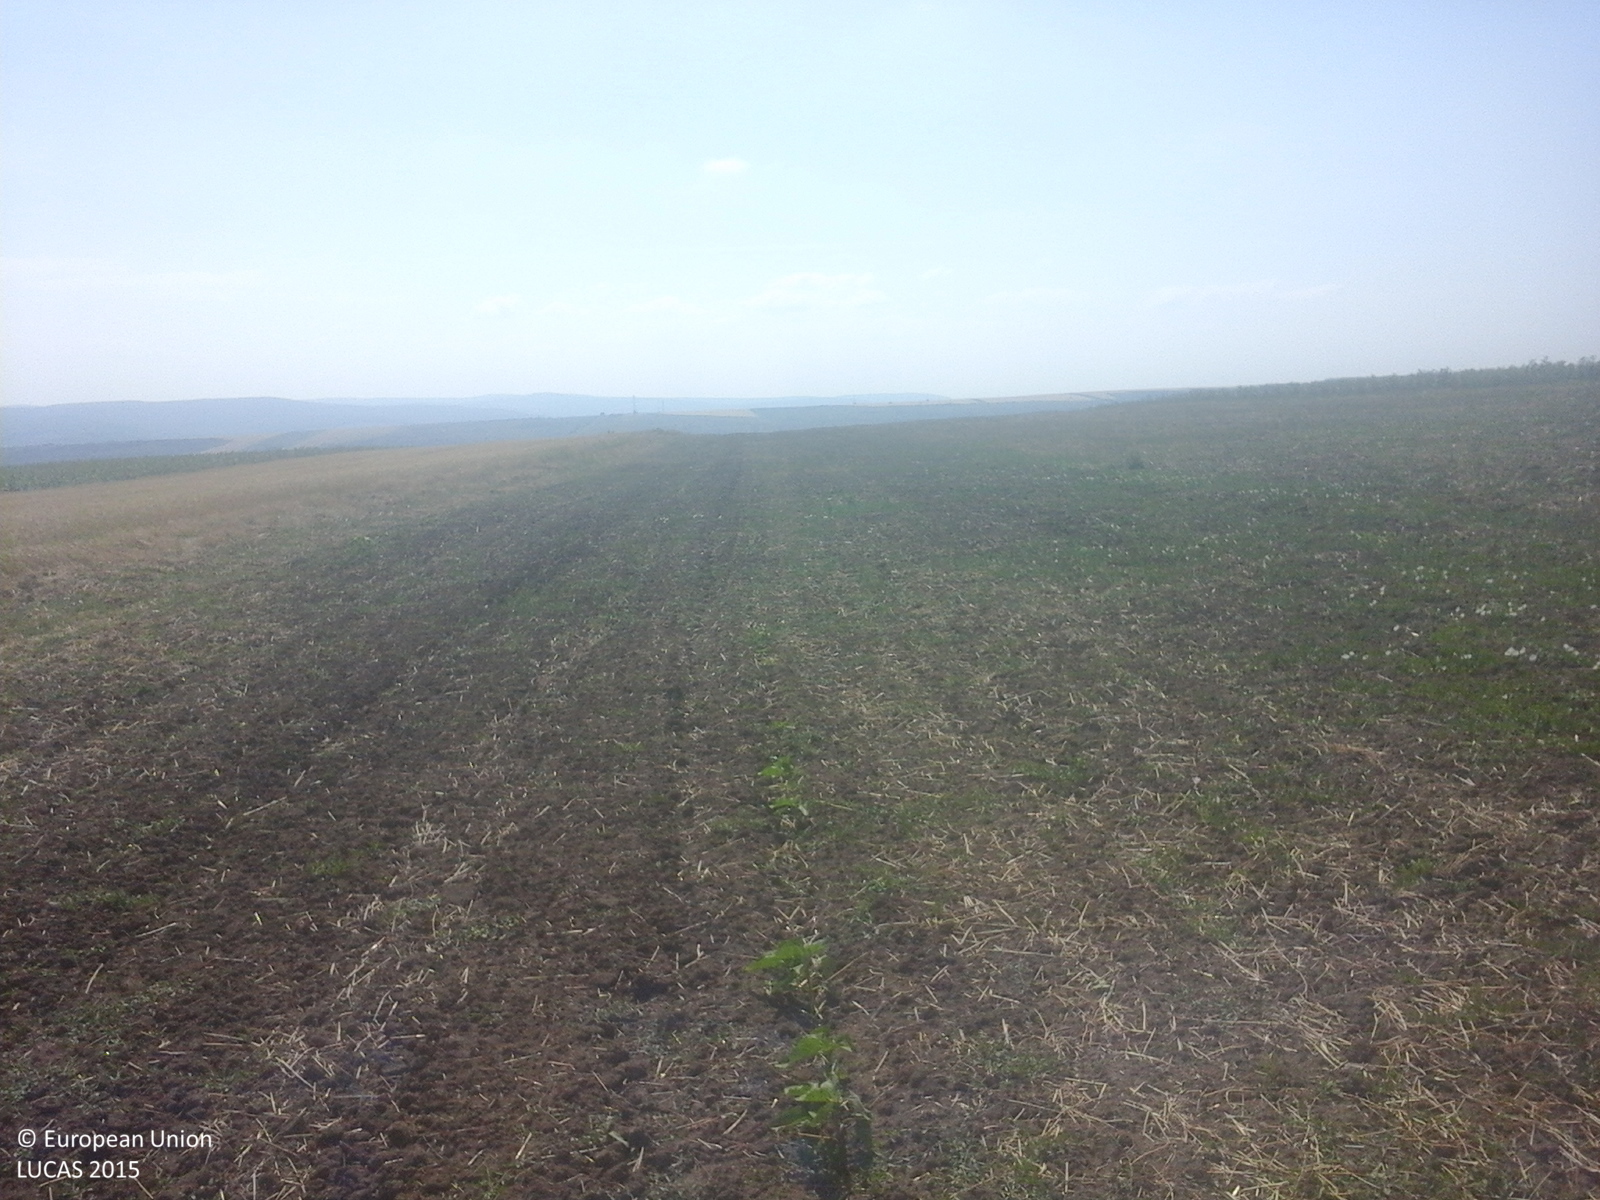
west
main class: Grassland
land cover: Spontaneously vegetated surfaces
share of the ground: < 10 %
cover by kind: herbaceous plants 100 %
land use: Fallow land
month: June
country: RO
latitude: 46.8608
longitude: 27.5206
